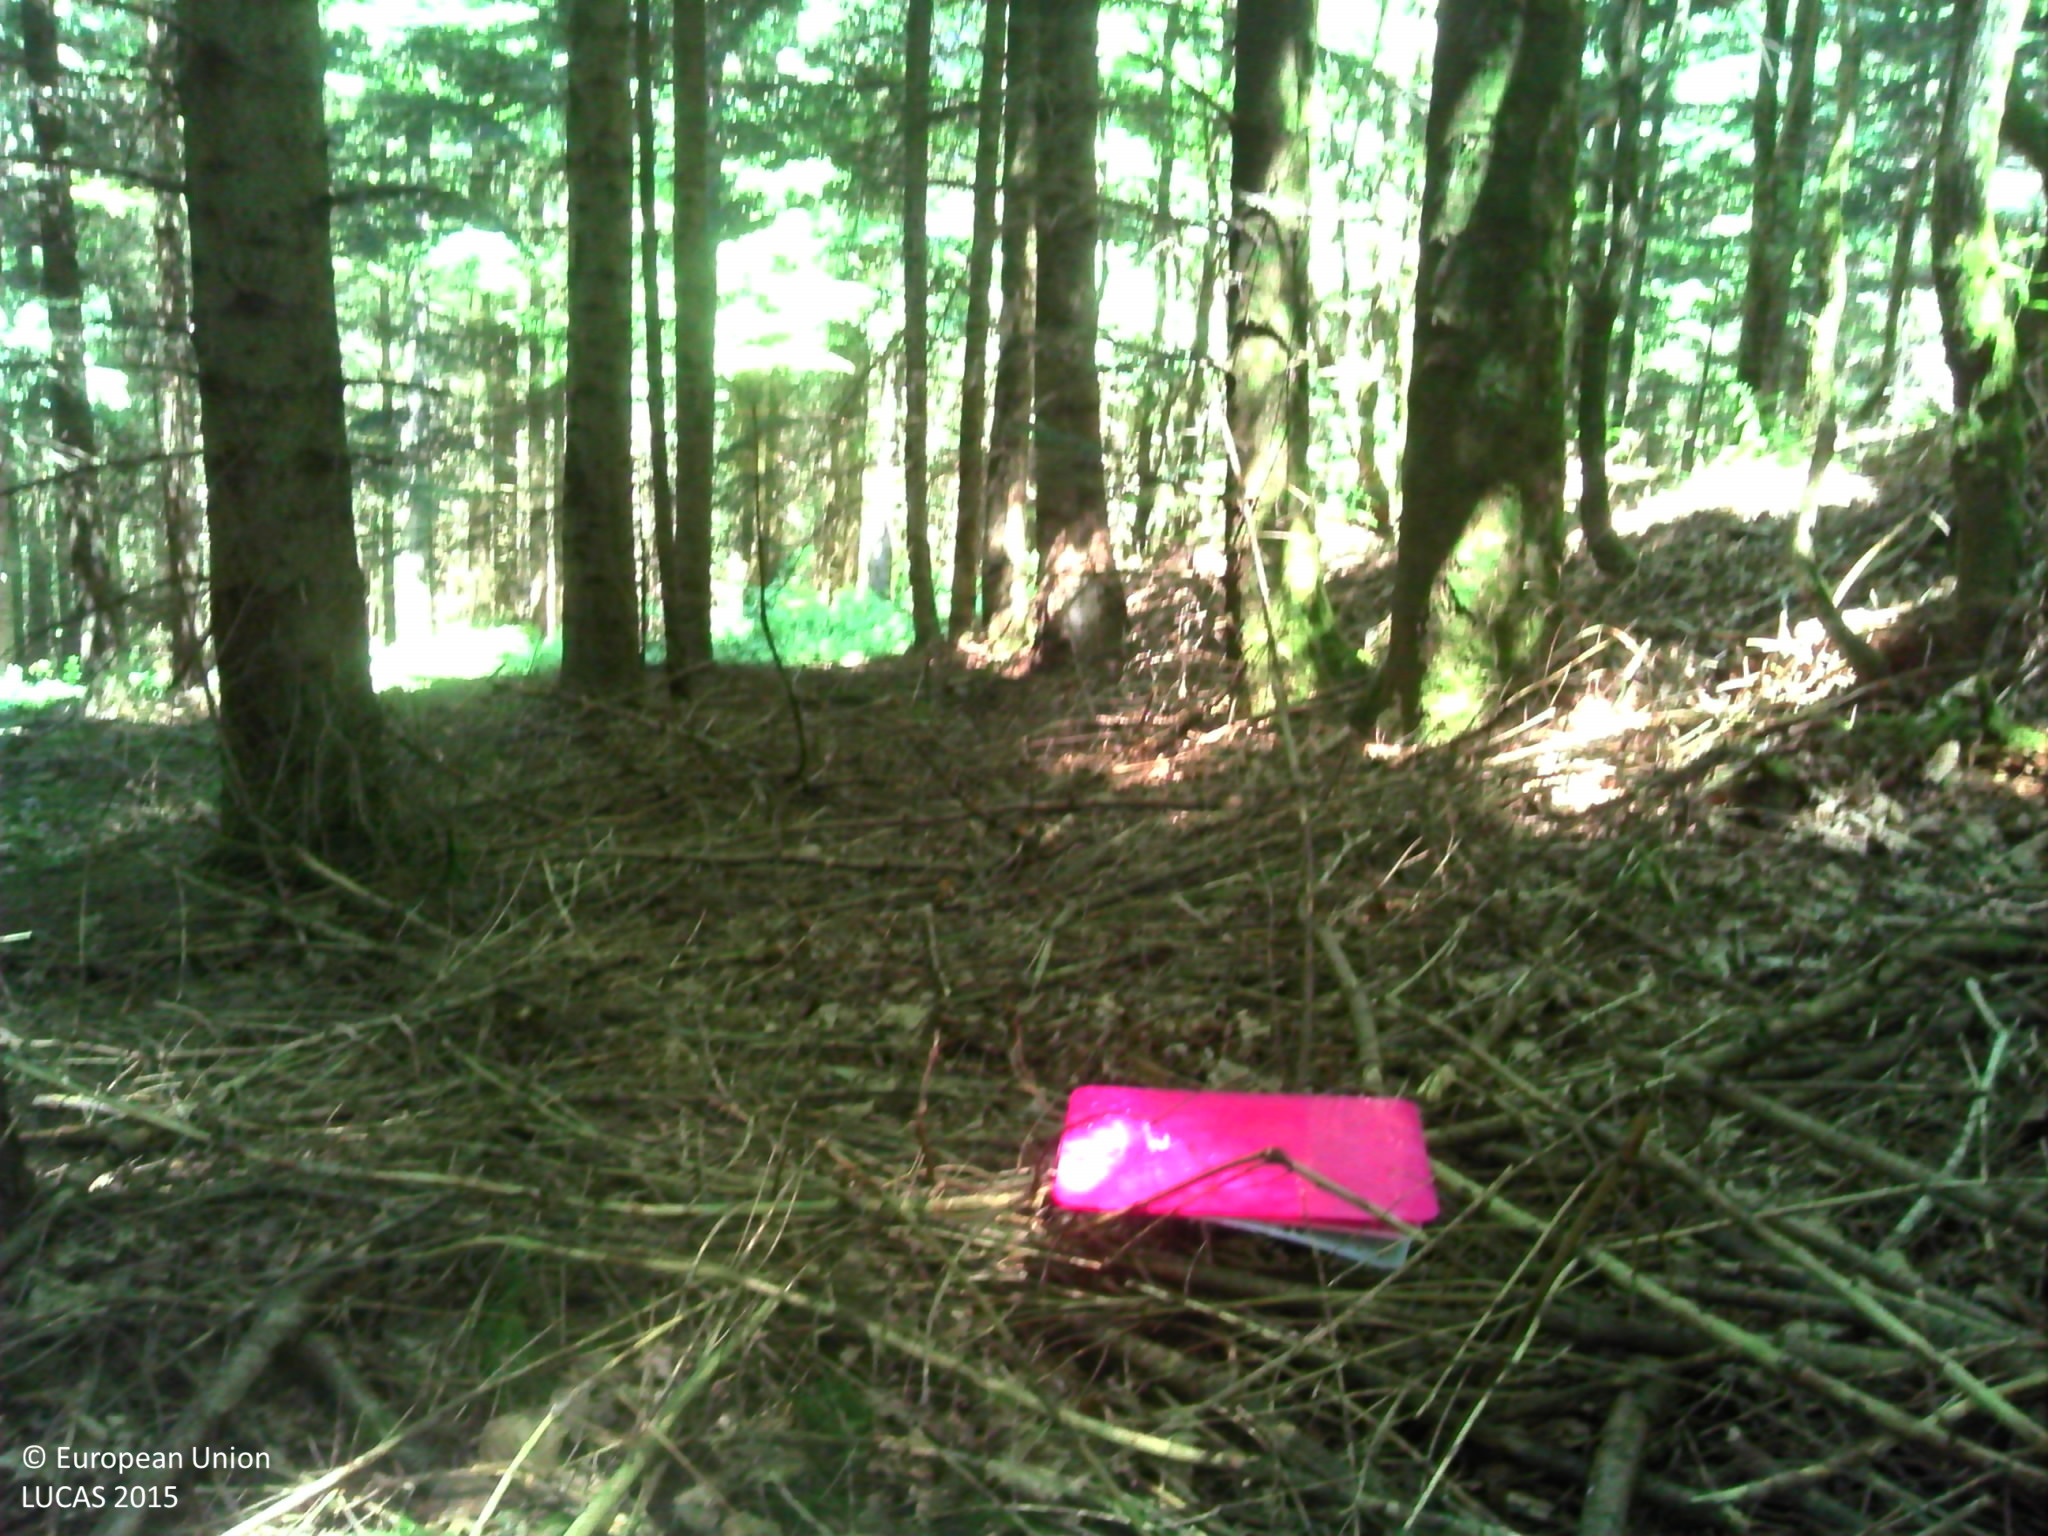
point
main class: Woodland
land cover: Spruce dominated coniferous woodland
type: exotic forest
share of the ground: > 75 %
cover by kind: coniferous forest trees 100 %
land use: Forestry
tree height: > 5 m
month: June
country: FR
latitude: 43.7577
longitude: 2.5662
